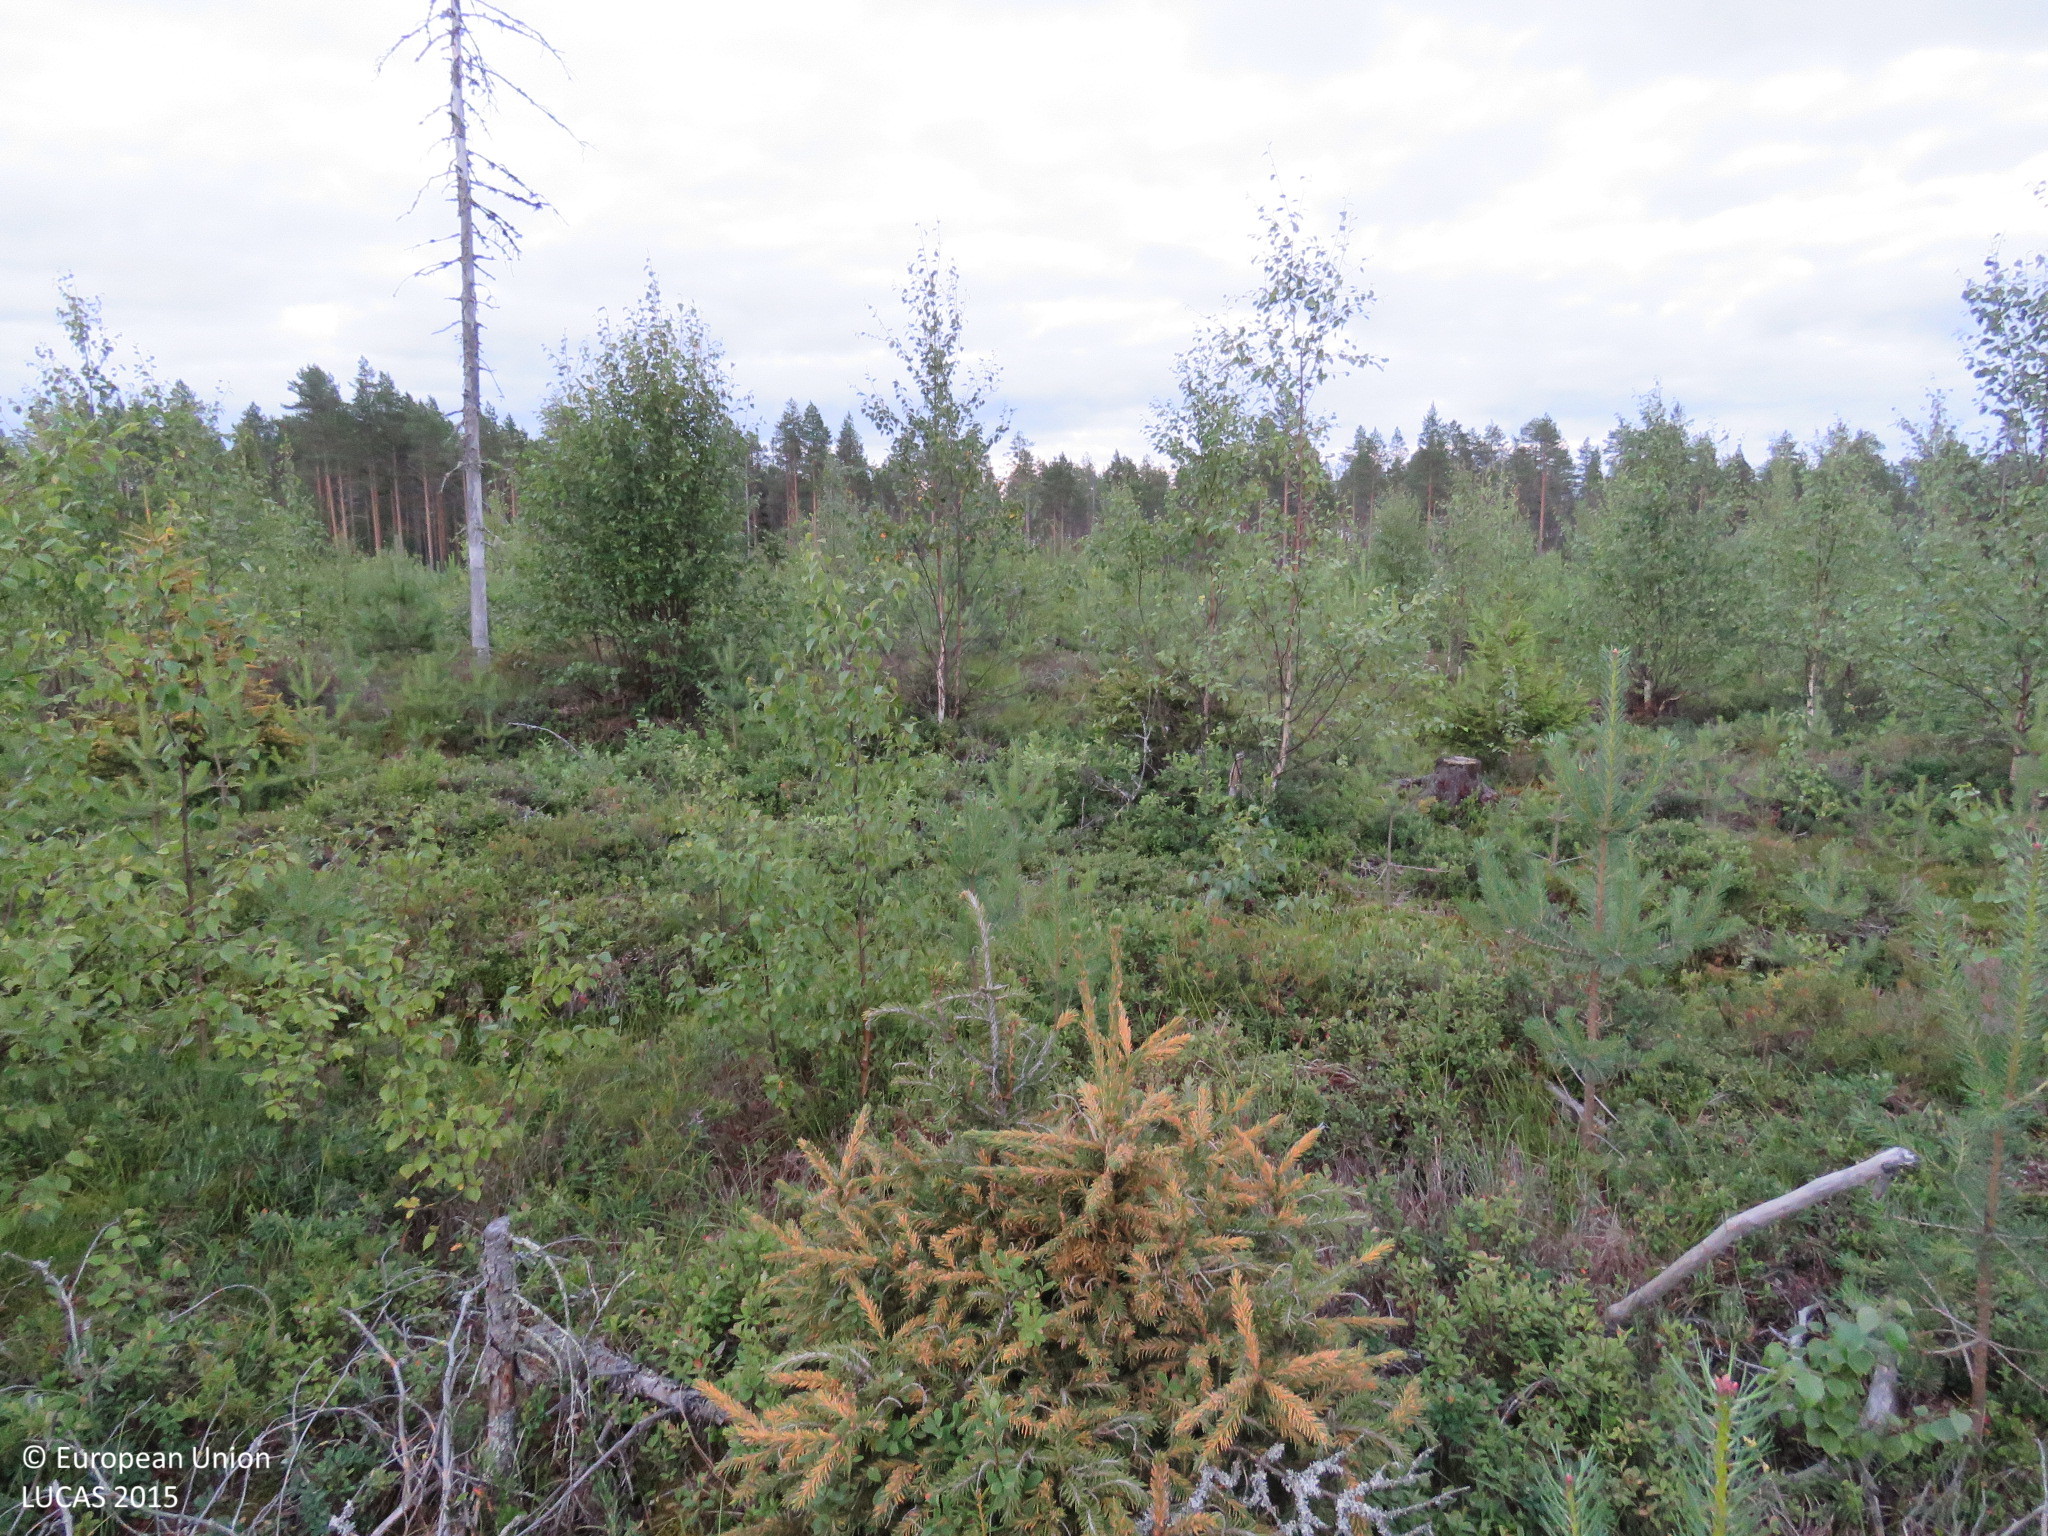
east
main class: Woodland
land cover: Pine dominated mixed woodland
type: boreal forest
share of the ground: 50 - 75 %
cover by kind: coniferous forest trees 30 %, broadleaved forest trees 30 %, shrubs 20 %, lichens and mosses 15 %, herbaceous plants 5 %
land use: Forestry
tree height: < 5 m
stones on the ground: < 10 %
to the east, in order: Pine dominated mixed woodland; Ditches and canals; Pine dominated mixed woodland; Ditches and canals; Pine dominated mixed woodland; Ditches and canals; Pine dominated mixed woodland; Ditches and canals; Pine dominated mixed woodland; Ditches and canals; Pine dominated mixed woodland; Ditches and canals; Pine dominated coniferous woodland; Ditches and canals; Broadleaved woodland; Tracks; Broadleaved woodland; Ditches and canals; Pine dominated mixed woodland
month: July
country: FI
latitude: 64.6865
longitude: 26.5687
